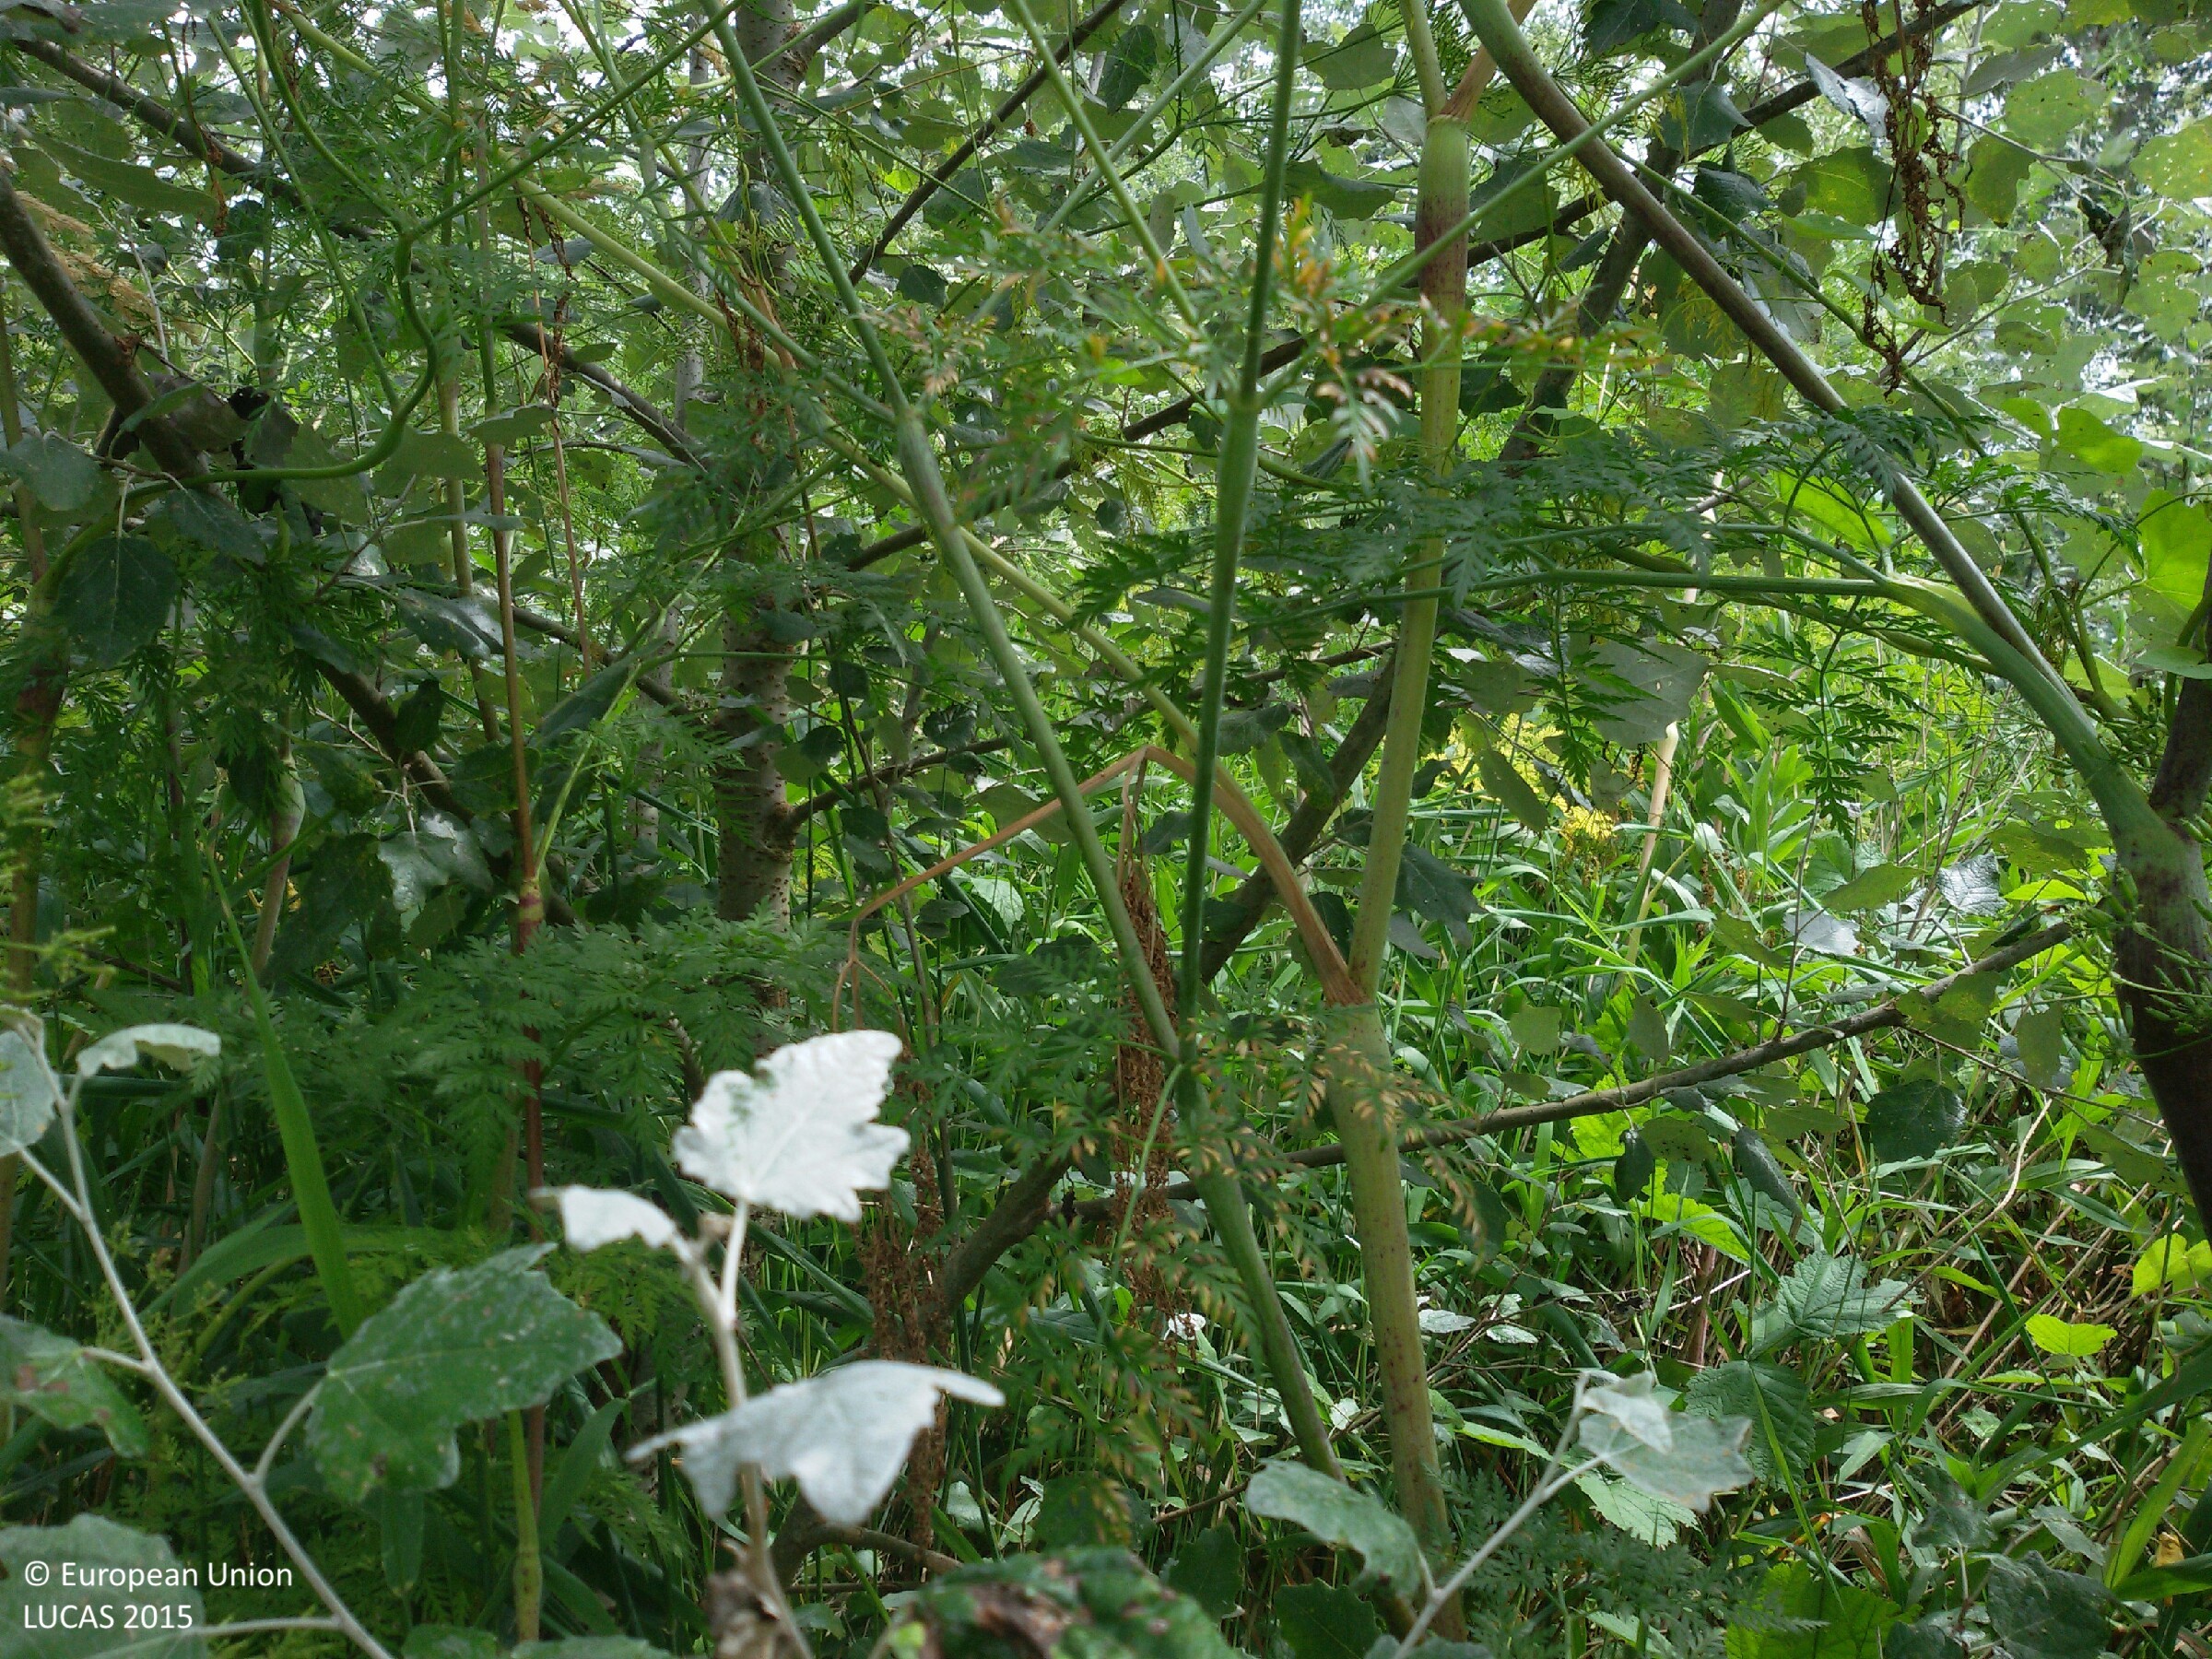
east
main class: Woodland
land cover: Broadleaved woodland
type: hemiboreal forest and nemoral coniferous forest and mixed broadleaved-coniferous forest
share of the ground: > 75 %
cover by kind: broadleaved forest trees 100 %
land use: Semi-natural and natural areas not in use
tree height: > 5 m
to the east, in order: Broadleaved woodland; Inland fresh running water; Broadleaved woodland; Spontaneously vegetated surfaces; Broadleaved woodland
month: July
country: PL
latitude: 51.2219
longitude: 21.8109
